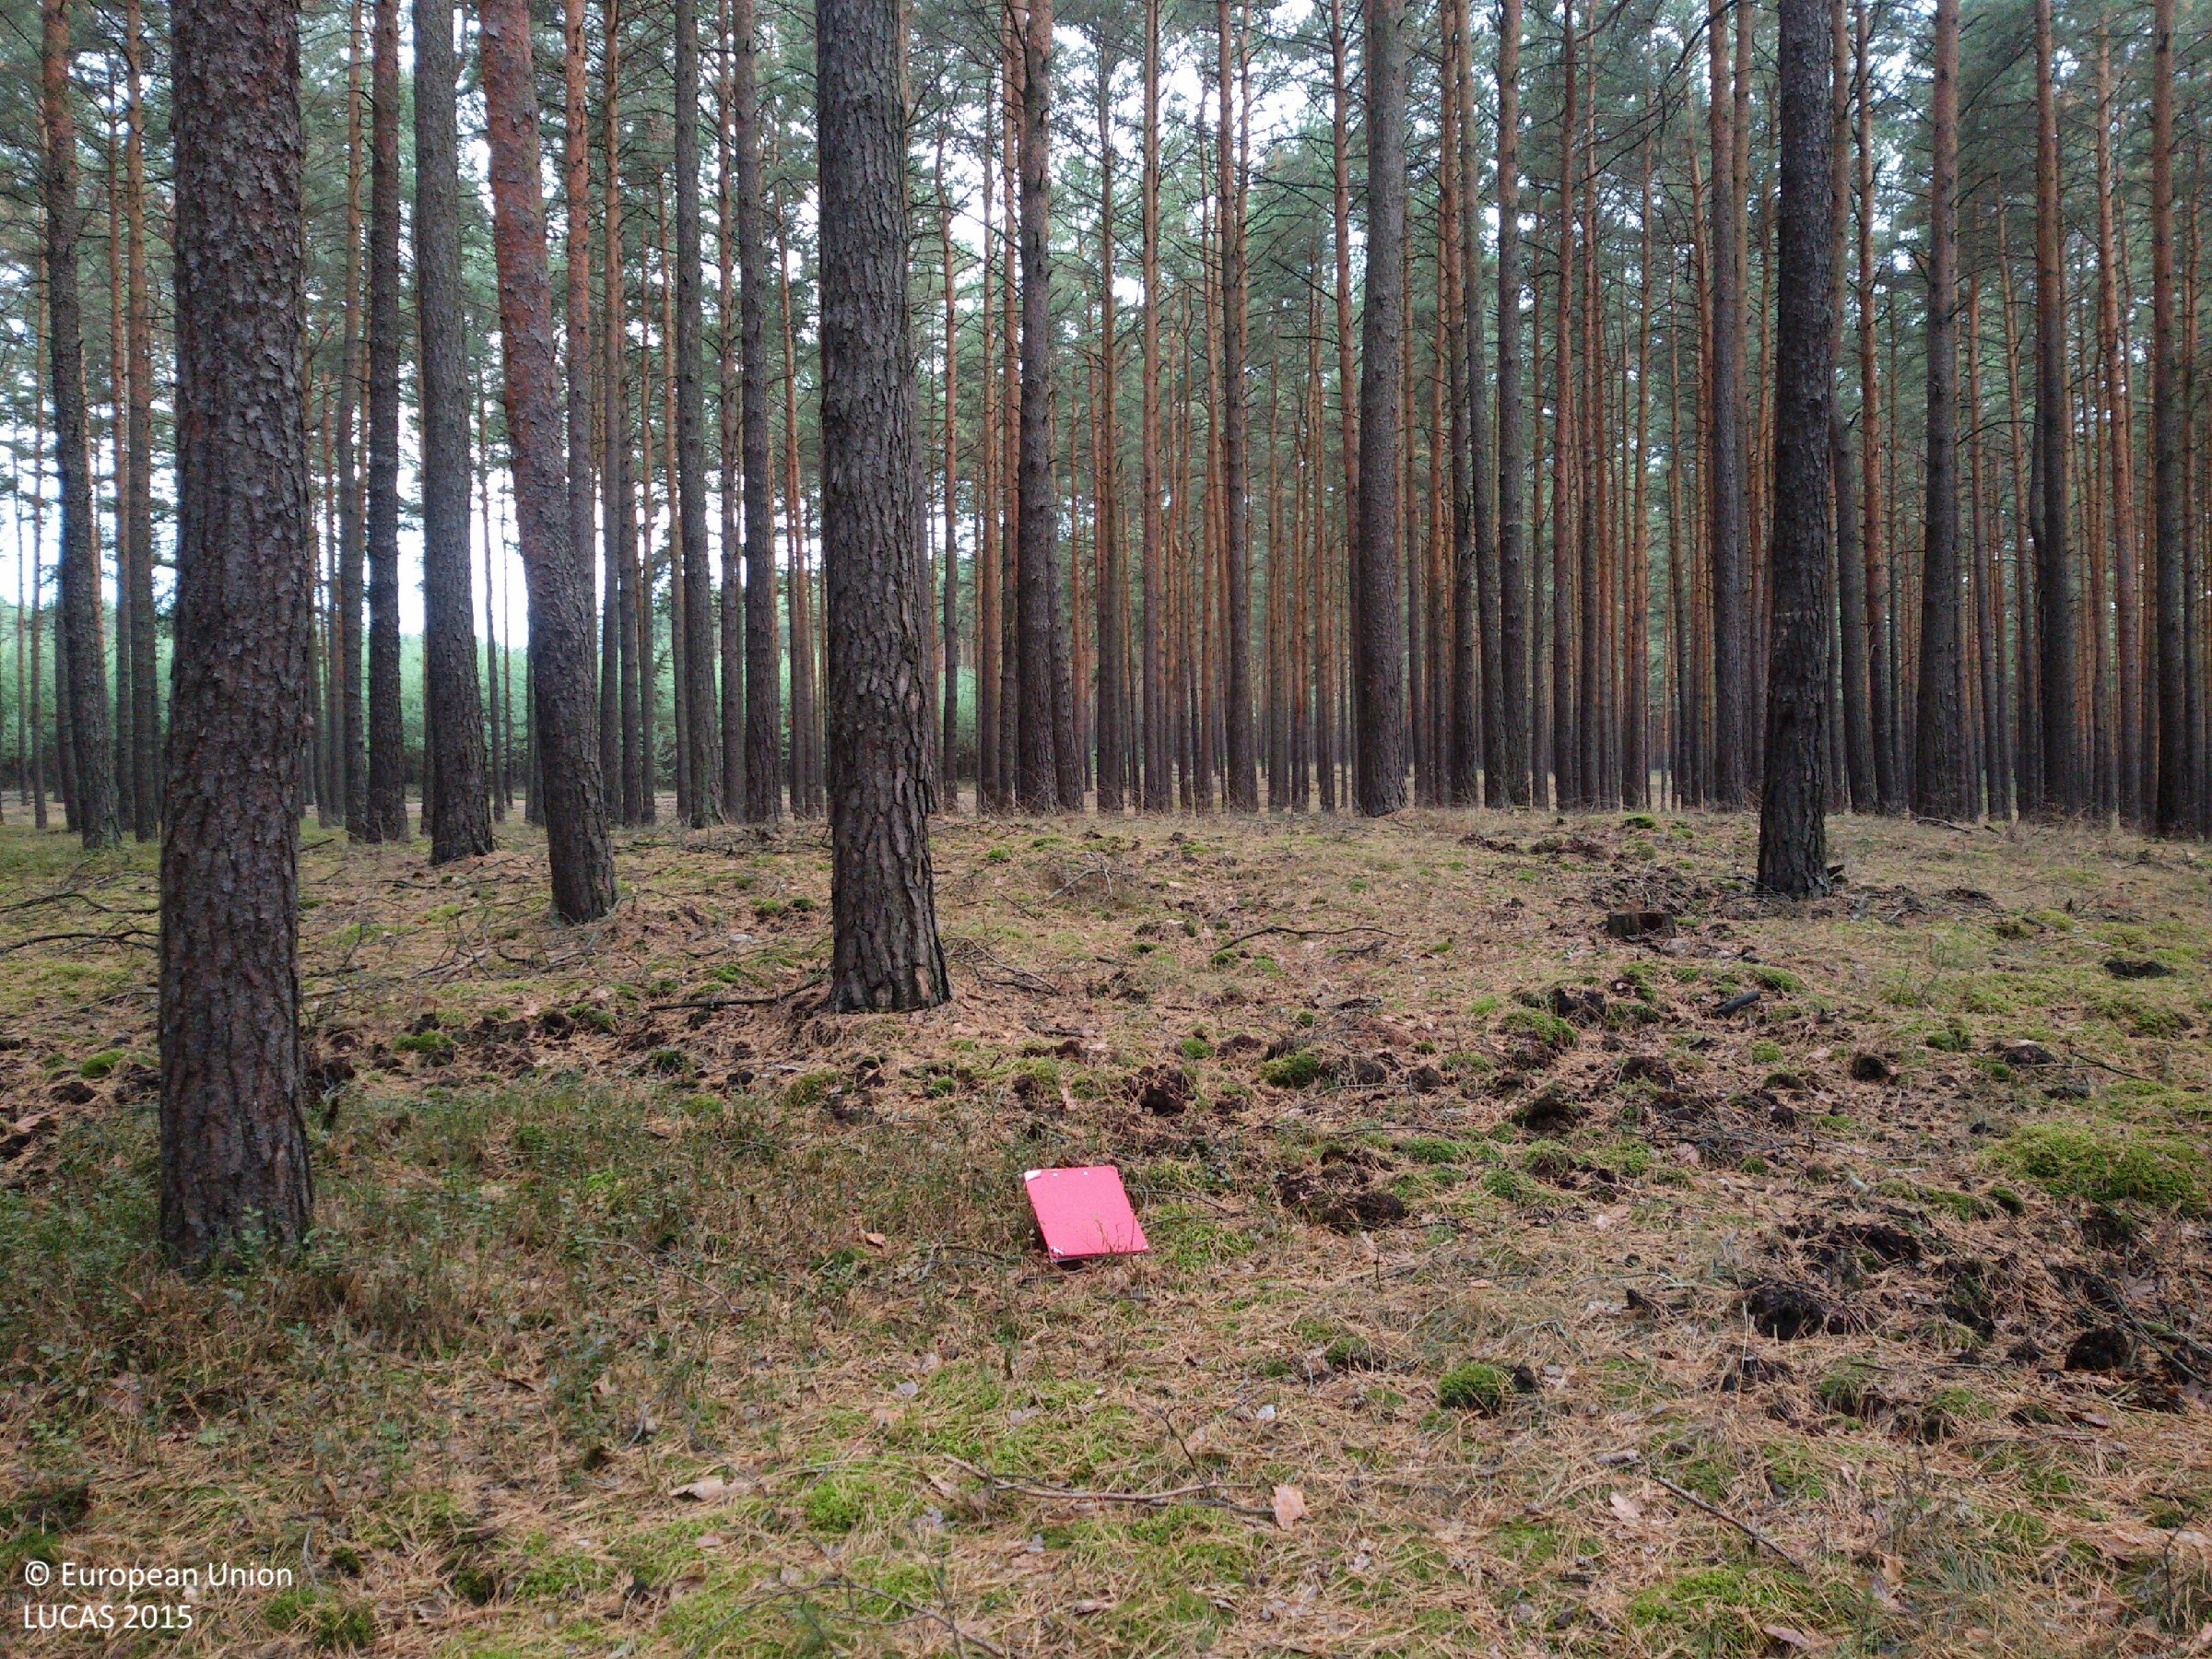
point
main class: Woodland
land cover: Pine dominated coniferous woodland
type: hemiboreal forest and nemoral coniferous forest and mixed broadleaved-coniferous forest
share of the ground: > 75 %
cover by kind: coniferous forest trees 85 %, lichens and mosses 10 %, herbaceous plants 5 %
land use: Forestry
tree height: > 5 m
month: September
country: PL
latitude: 51.8168
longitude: 14.6877
